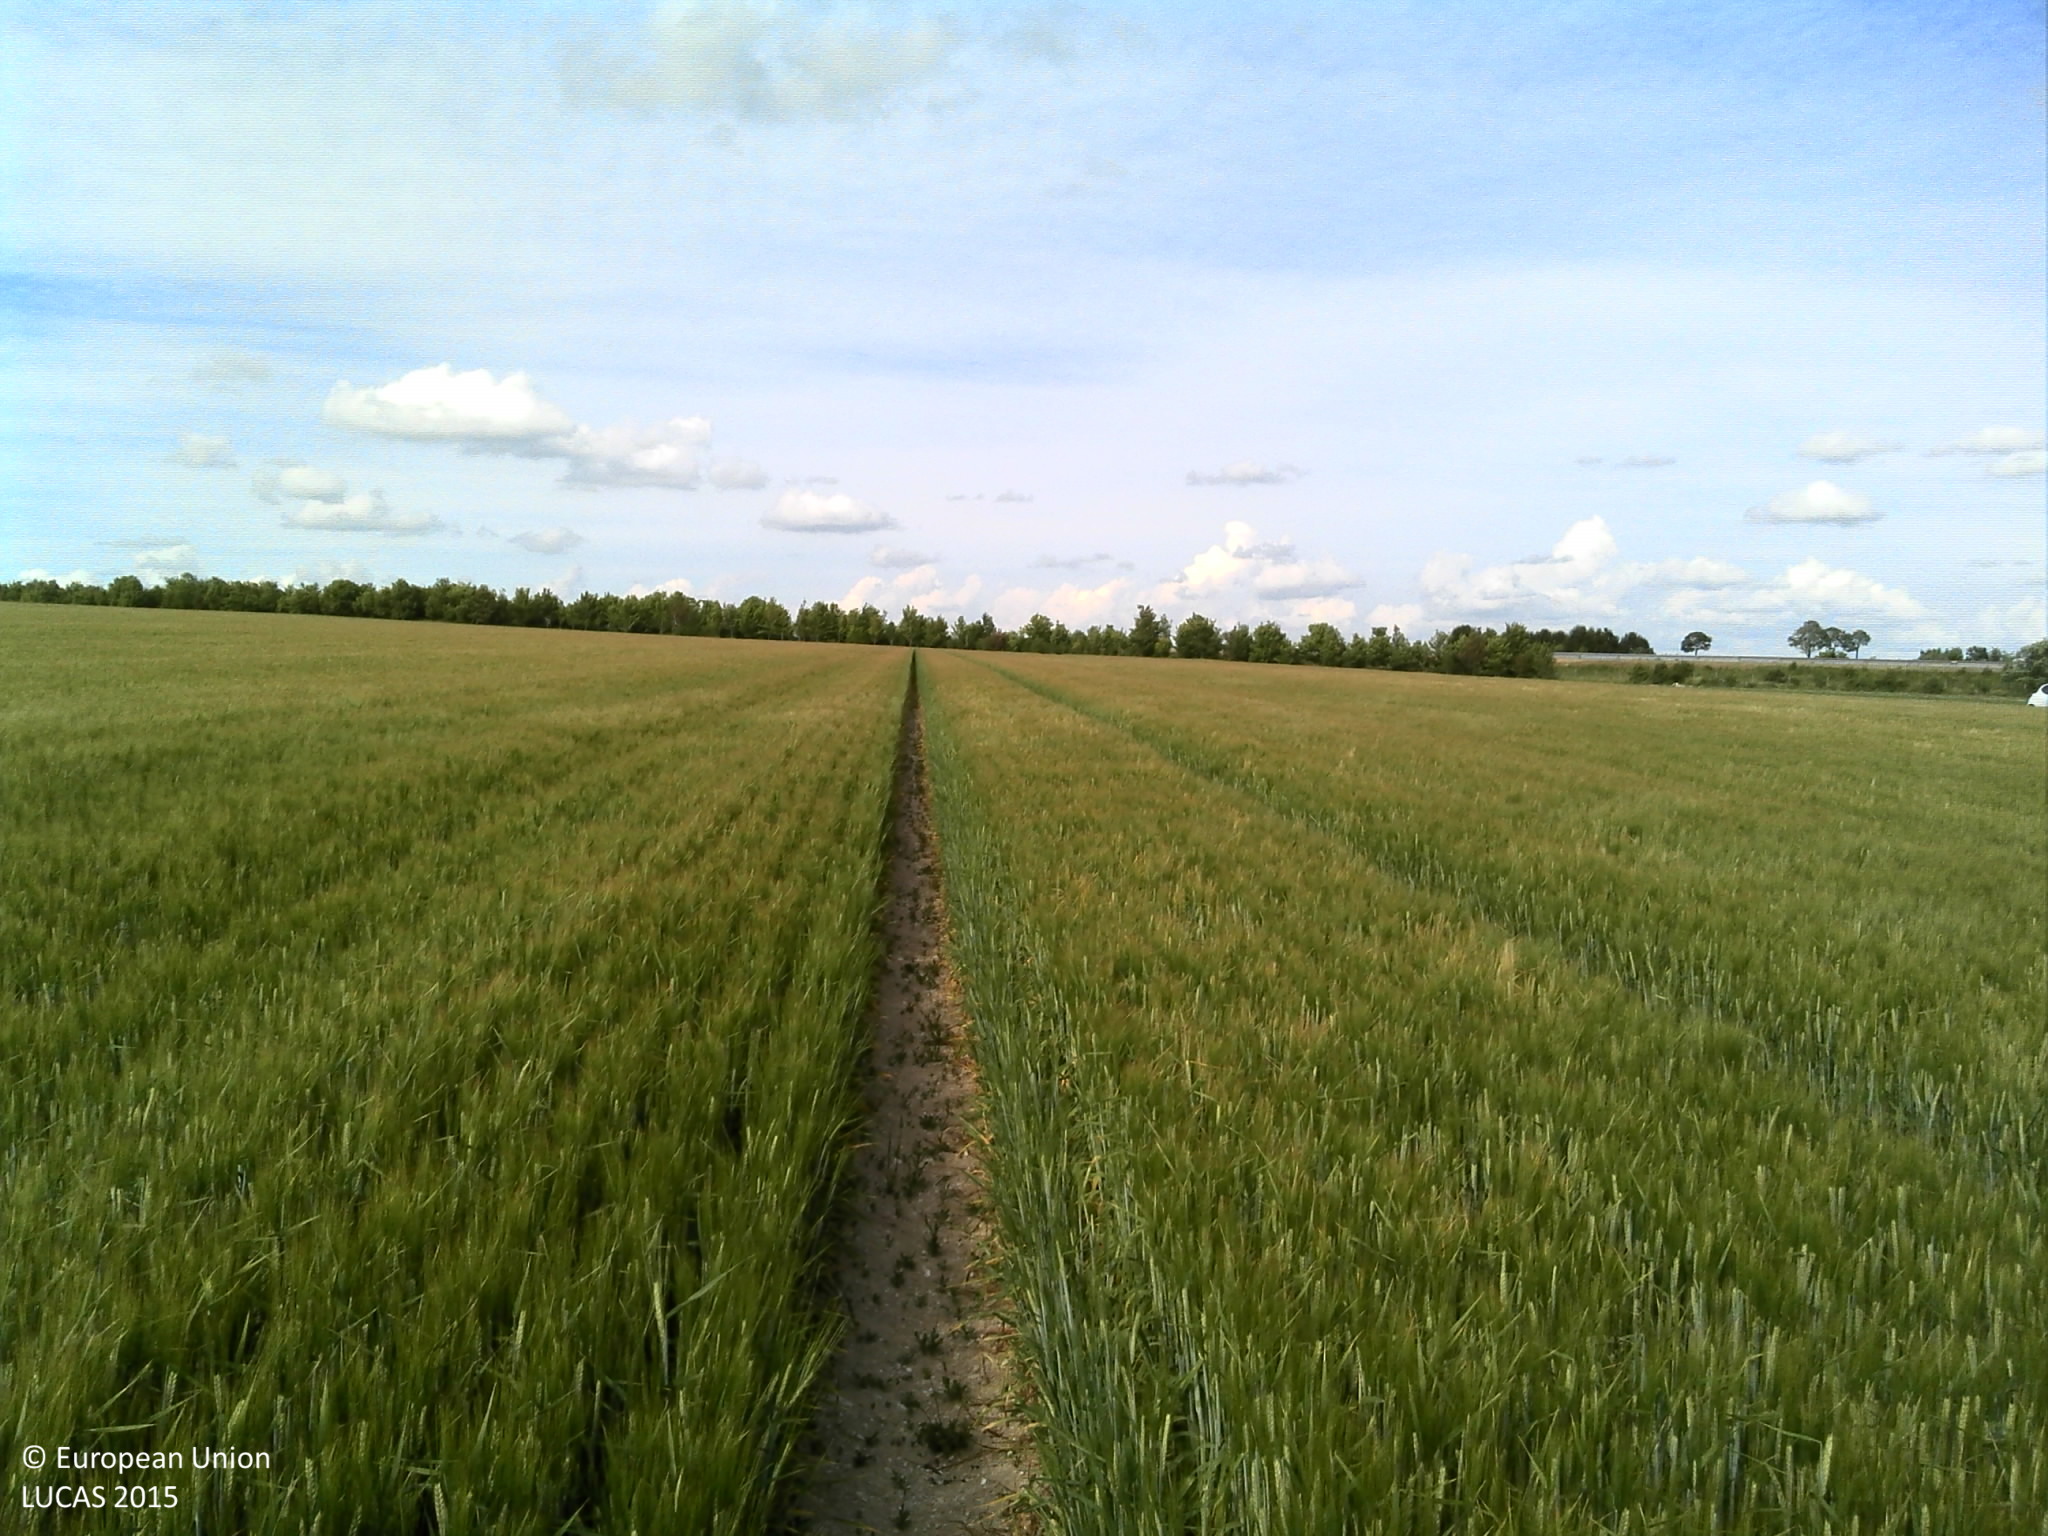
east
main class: Cropland
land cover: Barley
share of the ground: > 75 %
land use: Agriculture (excluding fallow land and kitchen gardens)
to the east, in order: Barley; Grass margins; Tracks; Grass margins; Sugar beet; Grass margins; Tracks; Grass margins; Fences; Grassland without tree/shrub cover
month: June
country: FR
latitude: 48.6467
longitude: 4.1733
